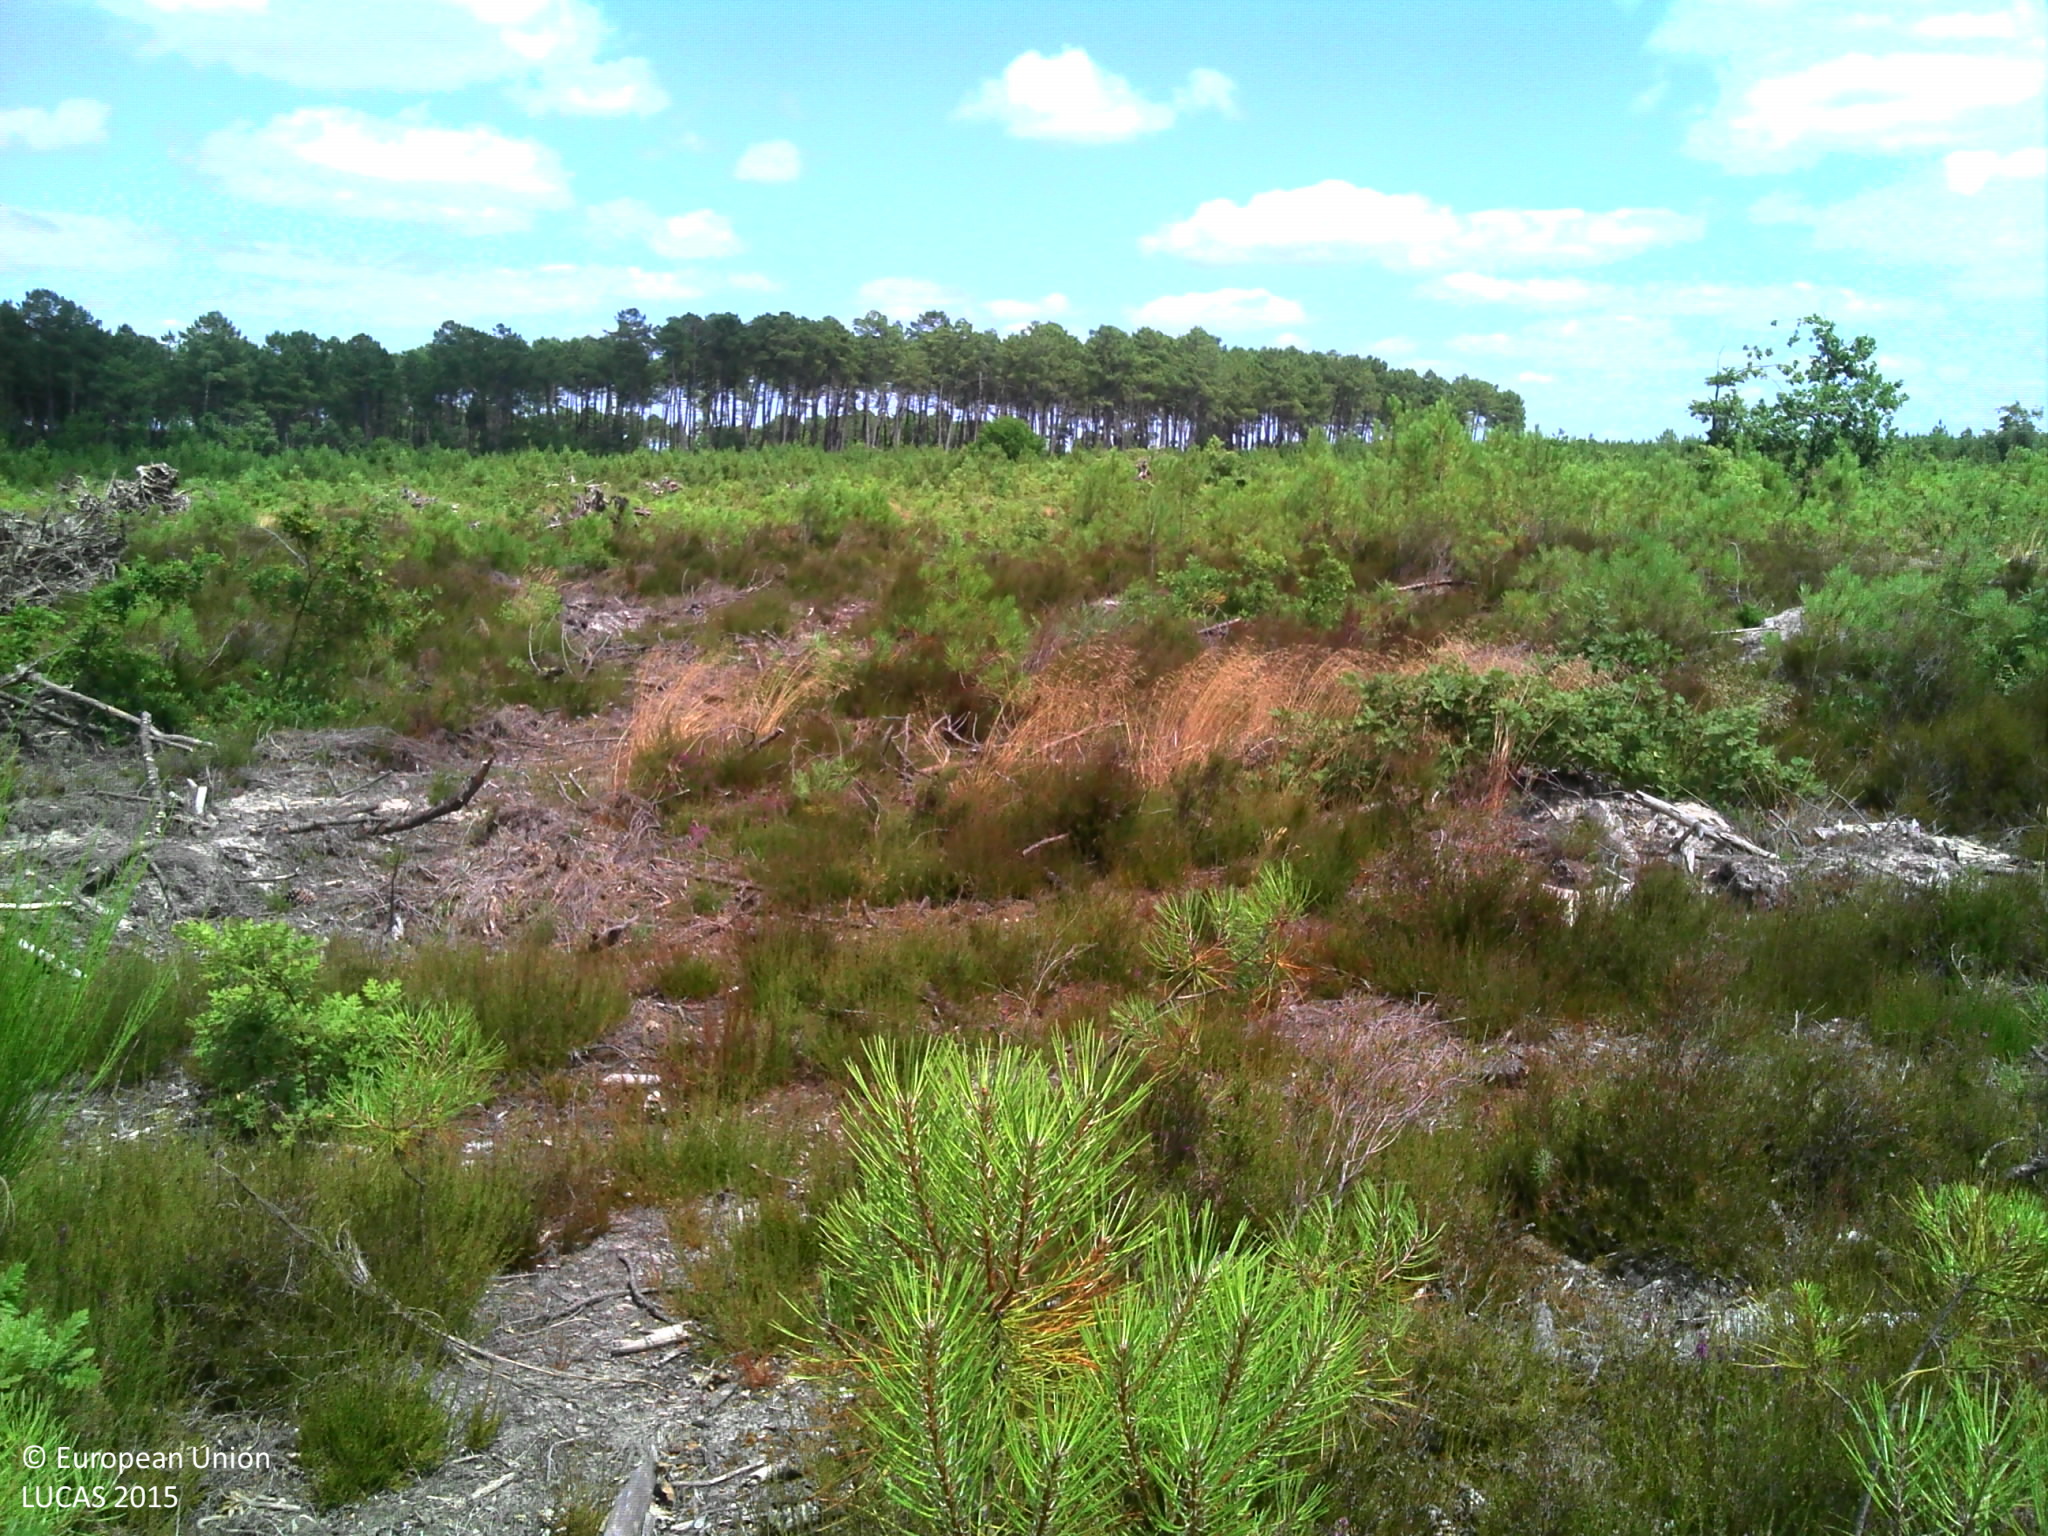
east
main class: Shrubland
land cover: Shrubland with sparse tree cover
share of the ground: > 75 %
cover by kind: shrubs 75 %, herbaceous plants 10 %, unconsolidated bare surface 10 %, broadleaved forest trees 5 %
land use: Forestry
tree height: < 5 m
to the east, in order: Shrubland with sparse tree cover; Pine dominated coniferous woodland
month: July
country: FR
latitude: 44.3339
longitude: -0.9425
